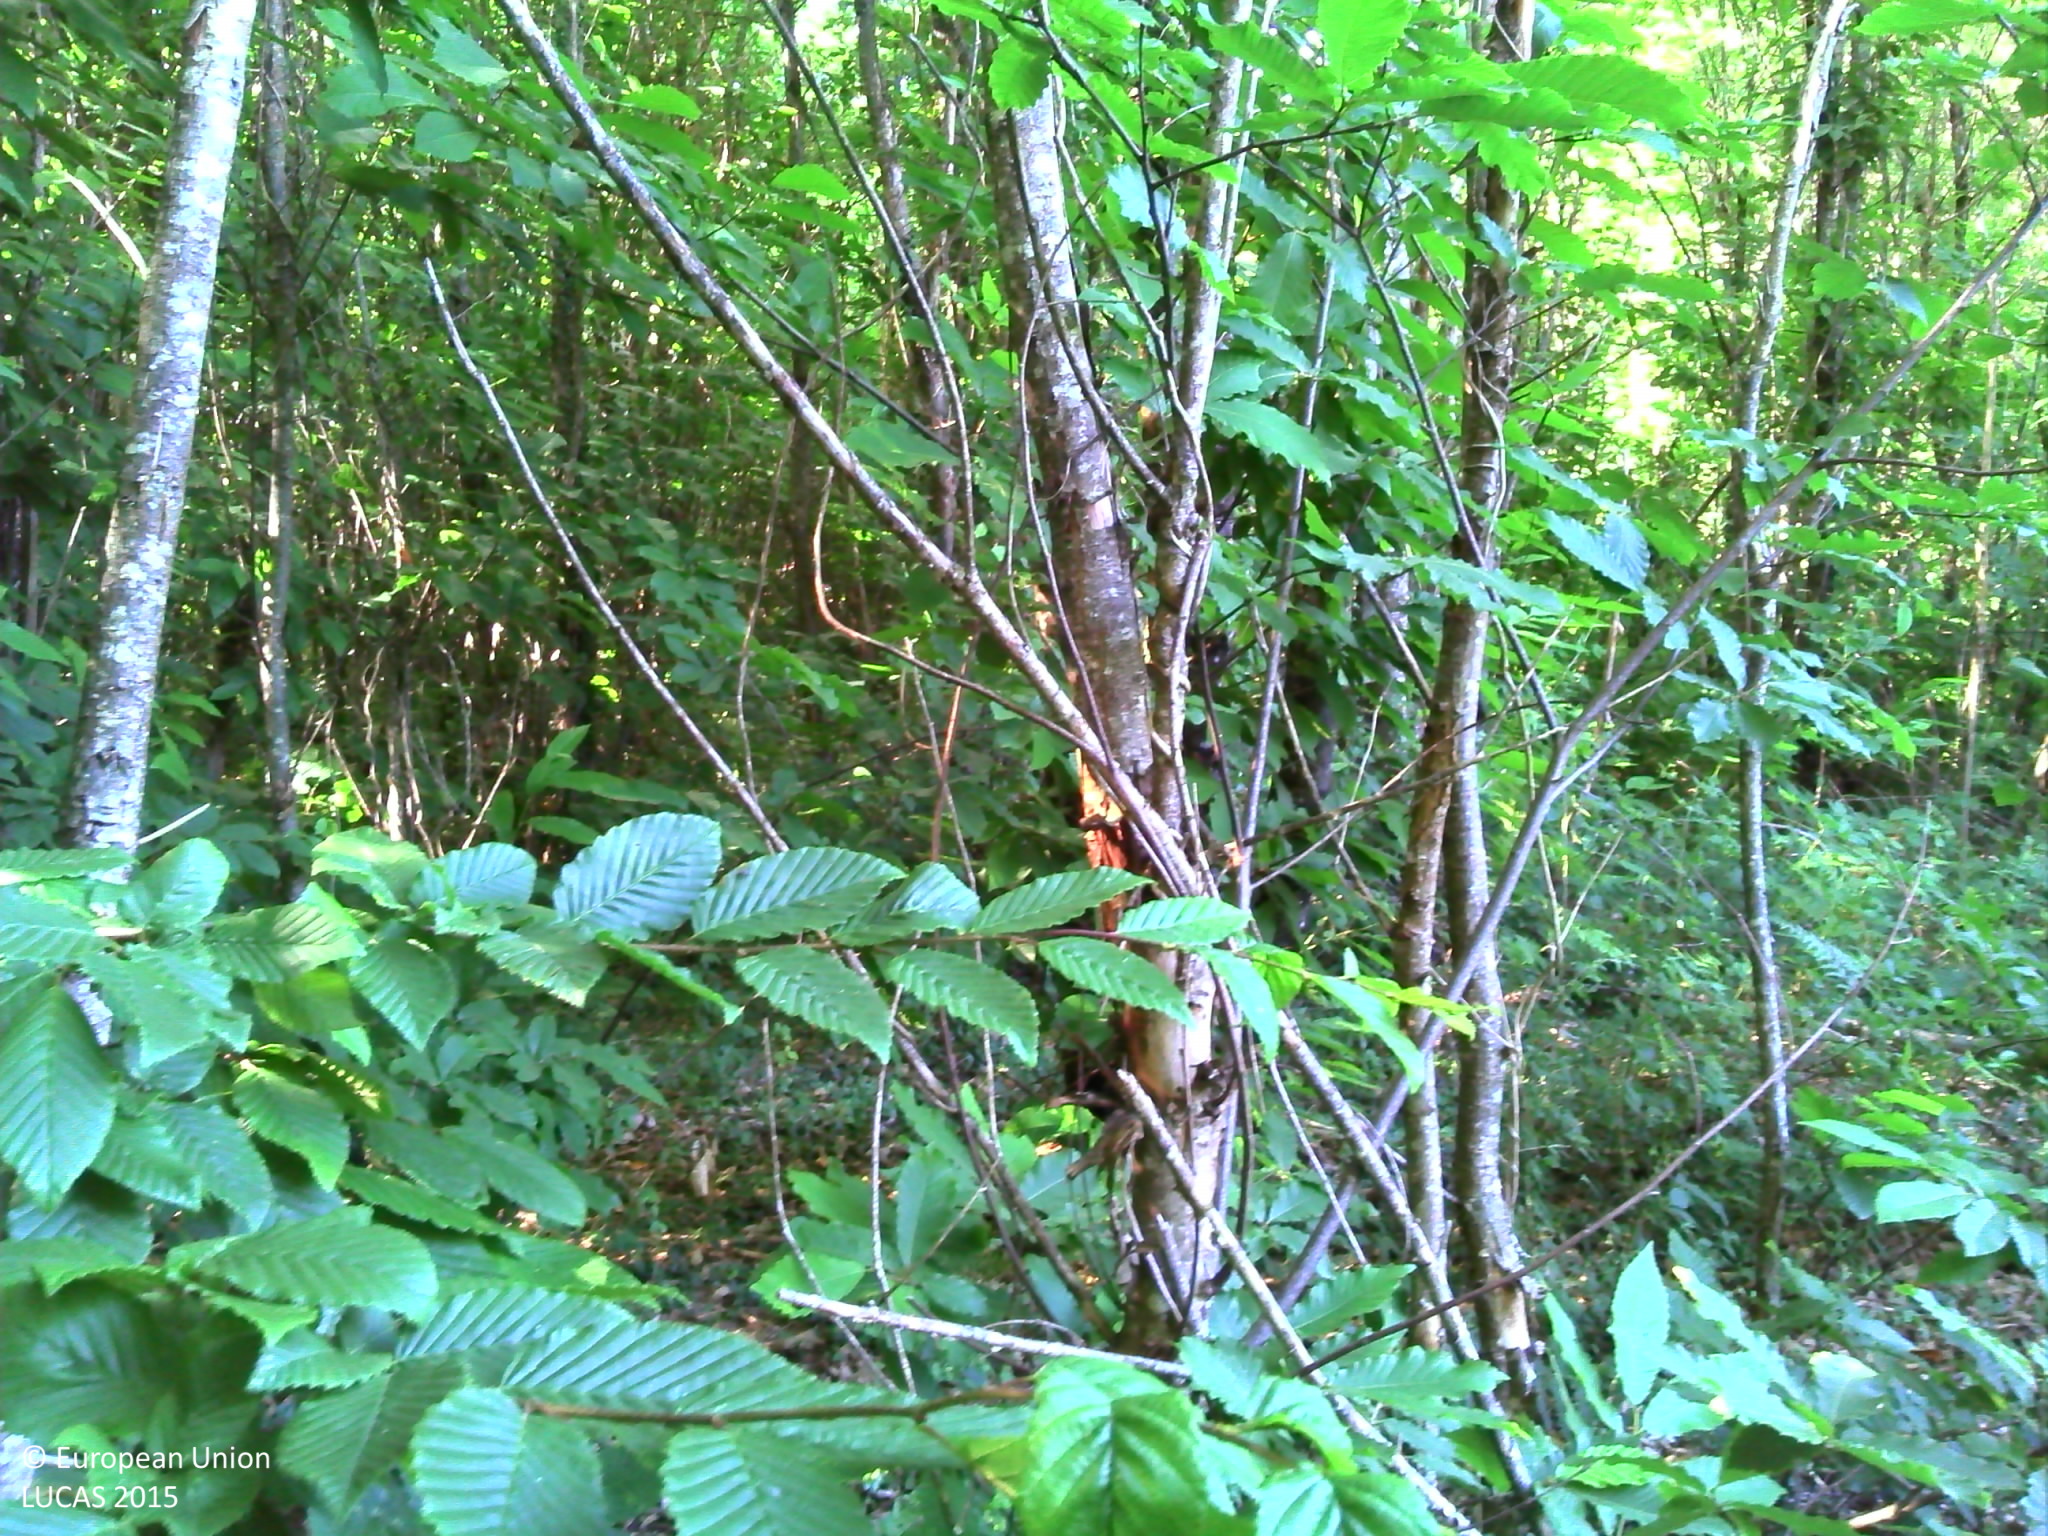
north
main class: Woodland
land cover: Broadleaved woodland
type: boreal forest
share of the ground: > 75 %
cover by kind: broadleaved forest trees 70 %, shrubs 20 %, herbaceous plants 5 %, lichens and mosses 5 %
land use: Forestry
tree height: > 5 m
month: June
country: FR
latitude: 45.7203
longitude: 0.4137
